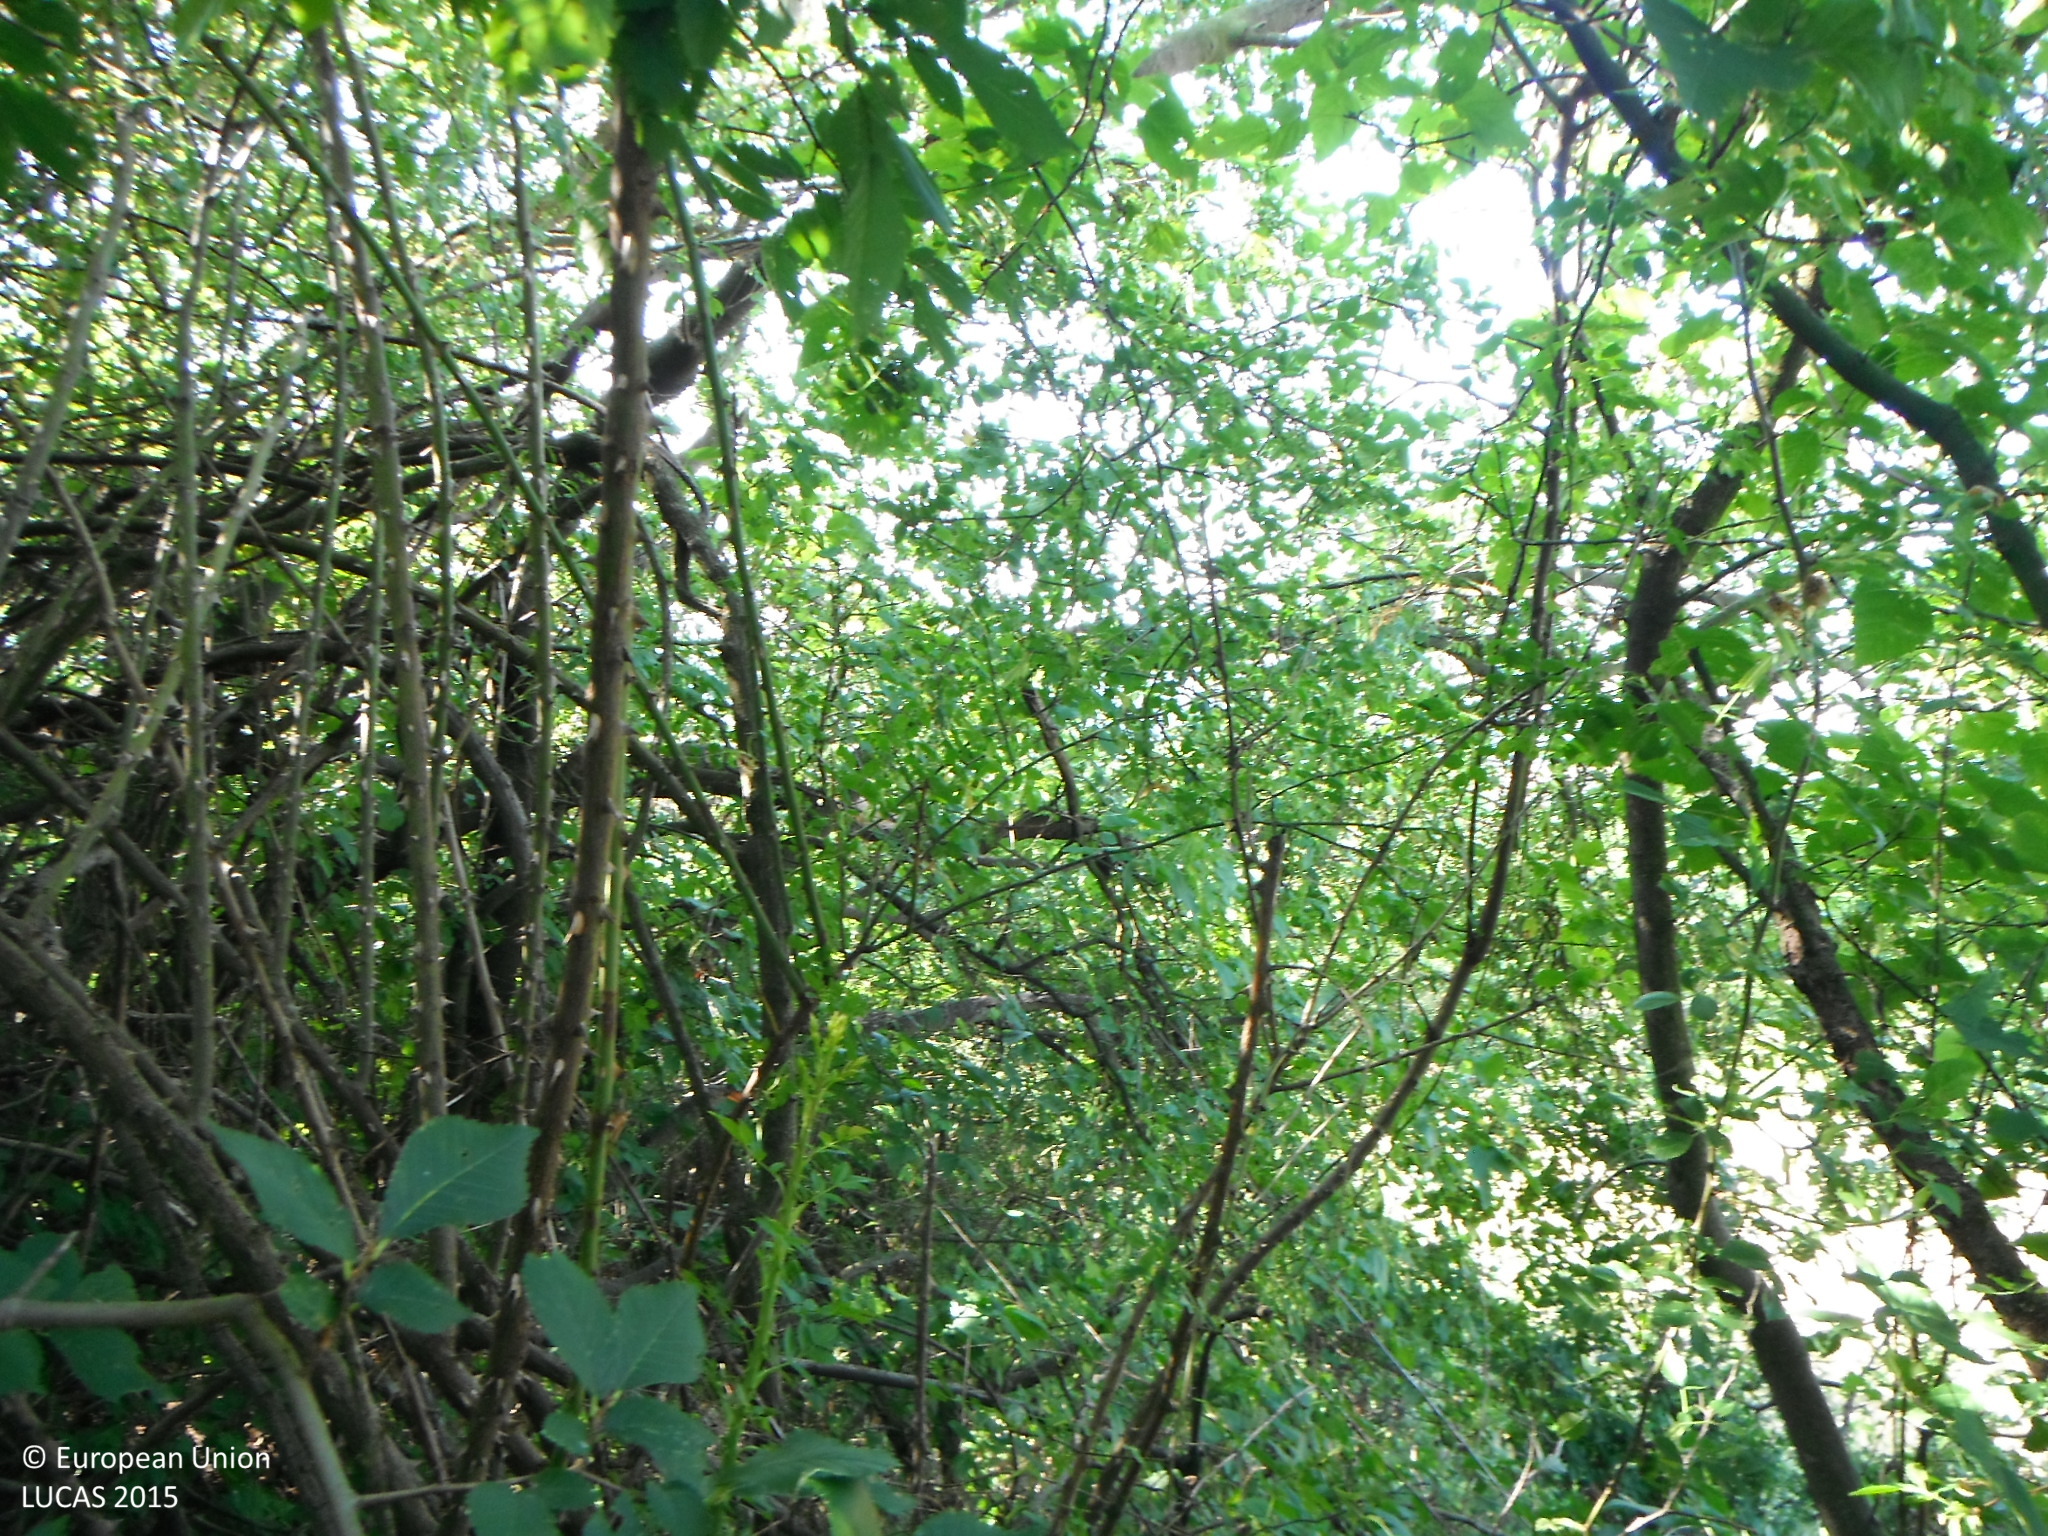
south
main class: Shrubland
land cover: Shrubland with sparse tree cover
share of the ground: > 75 %
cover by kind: shrubs 95 %, broadleaved forest trees 5 %
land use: Semi-natural and natural areas not in use
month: June
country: SK
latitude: 48.2058
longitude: 18.9136
